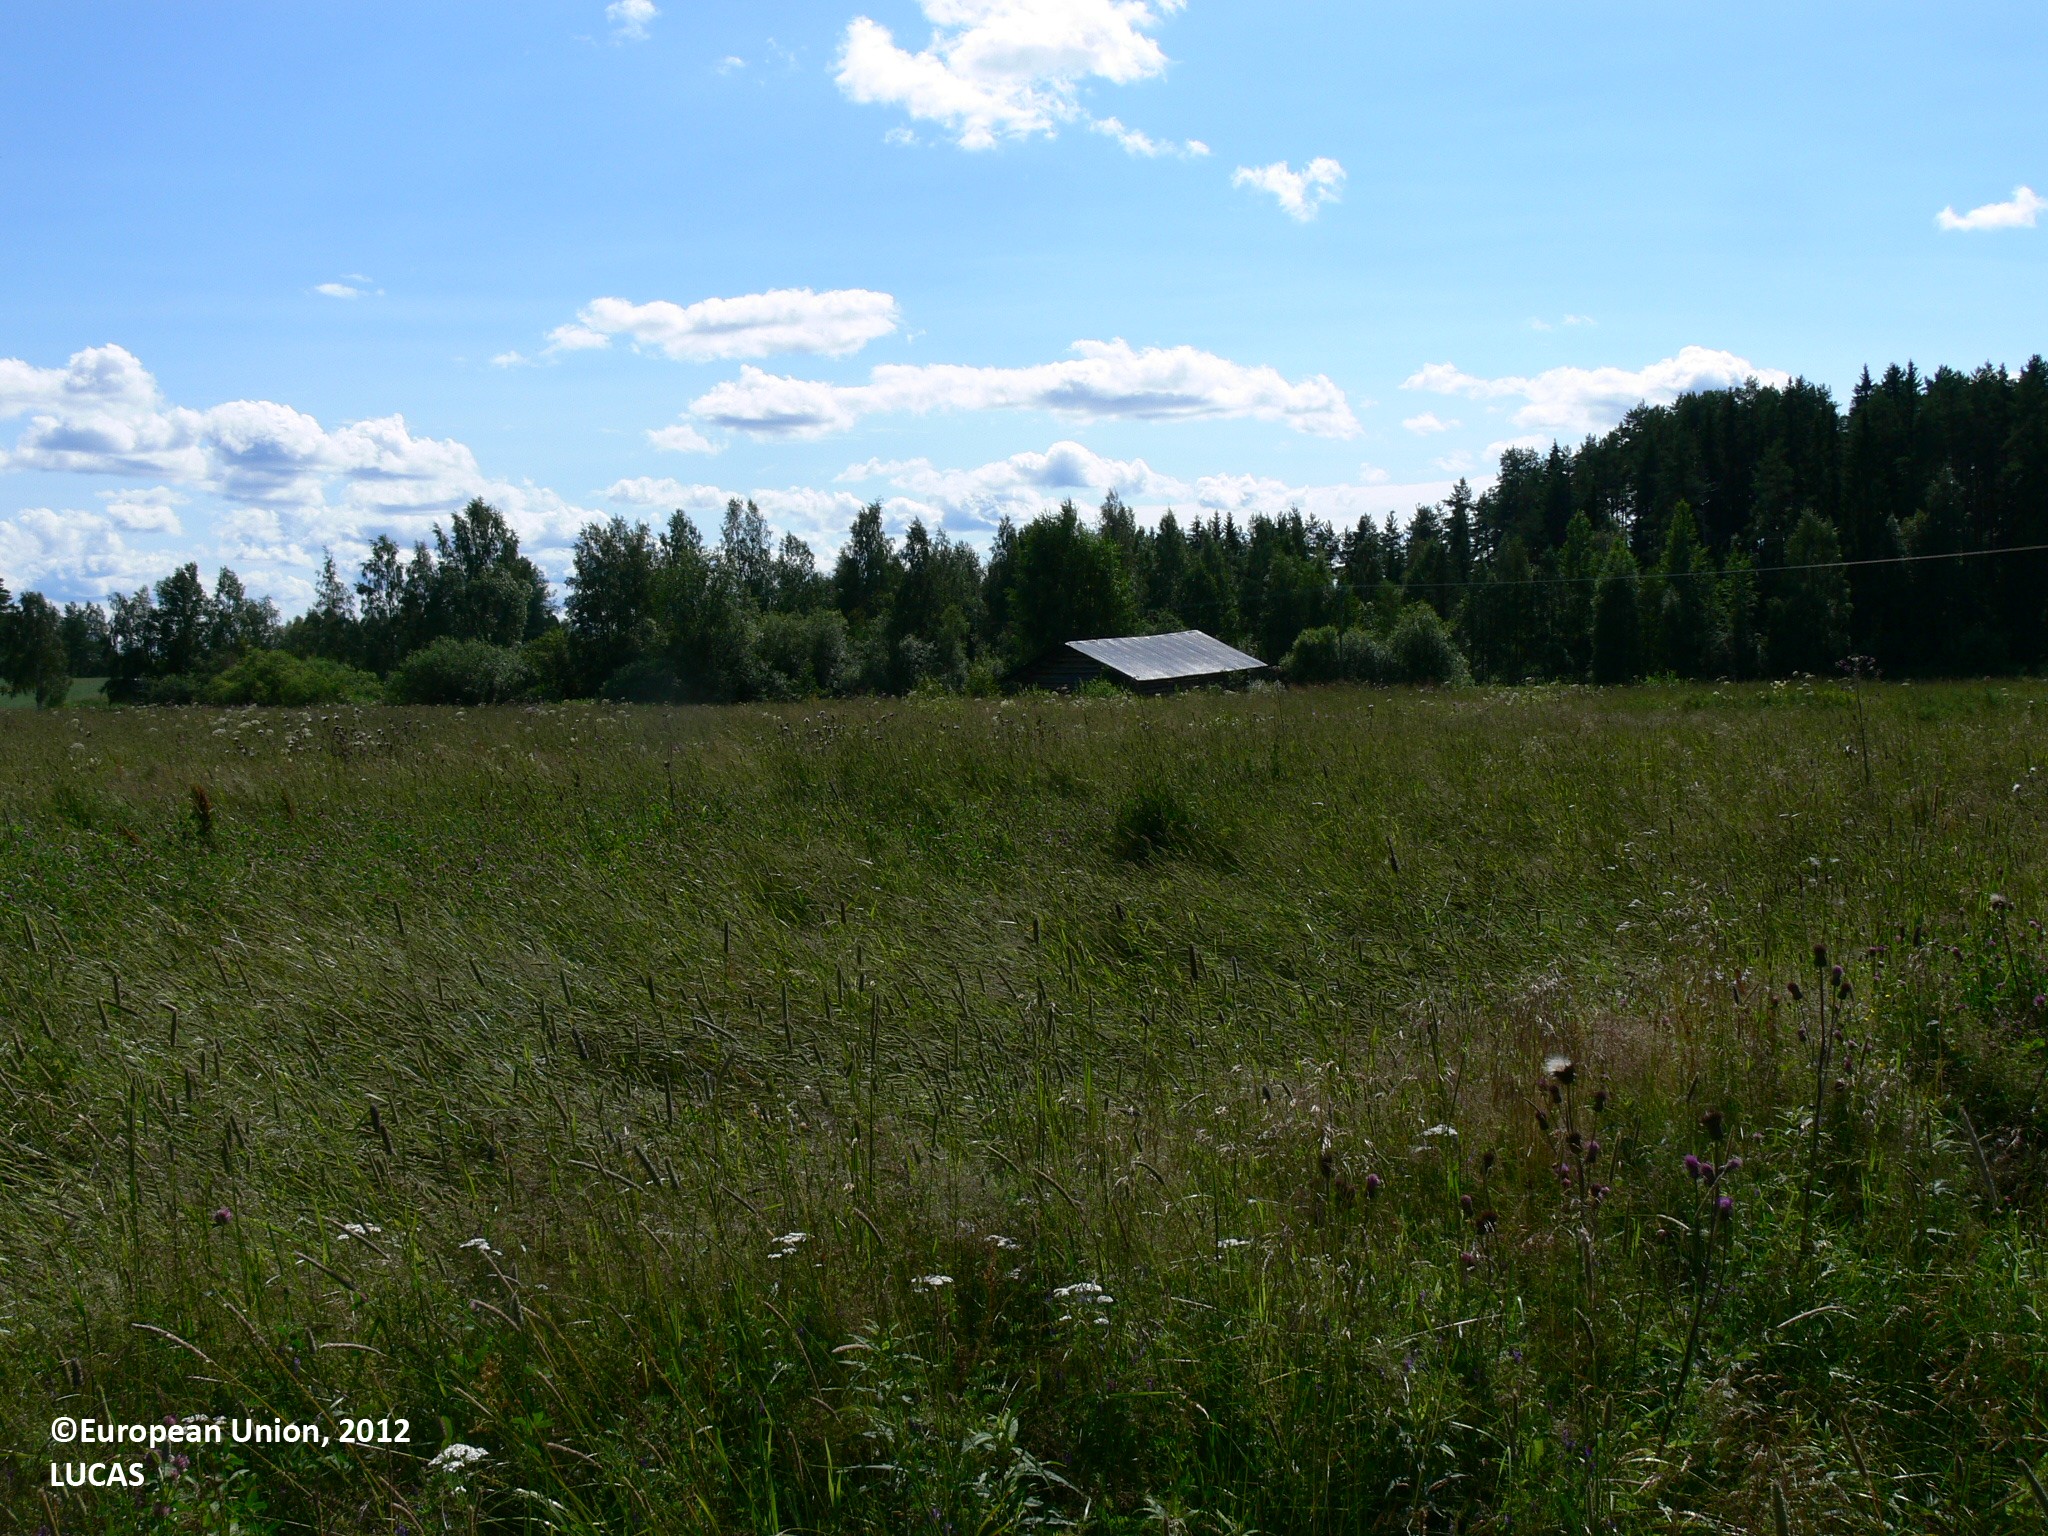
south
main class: Cropland
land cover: Temporary grasslands
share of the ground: > 75 %
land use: Agriculture (excluding fallow land and kitchen gardens)
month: July
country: FI
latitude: 63.2570
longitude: 29.2426
